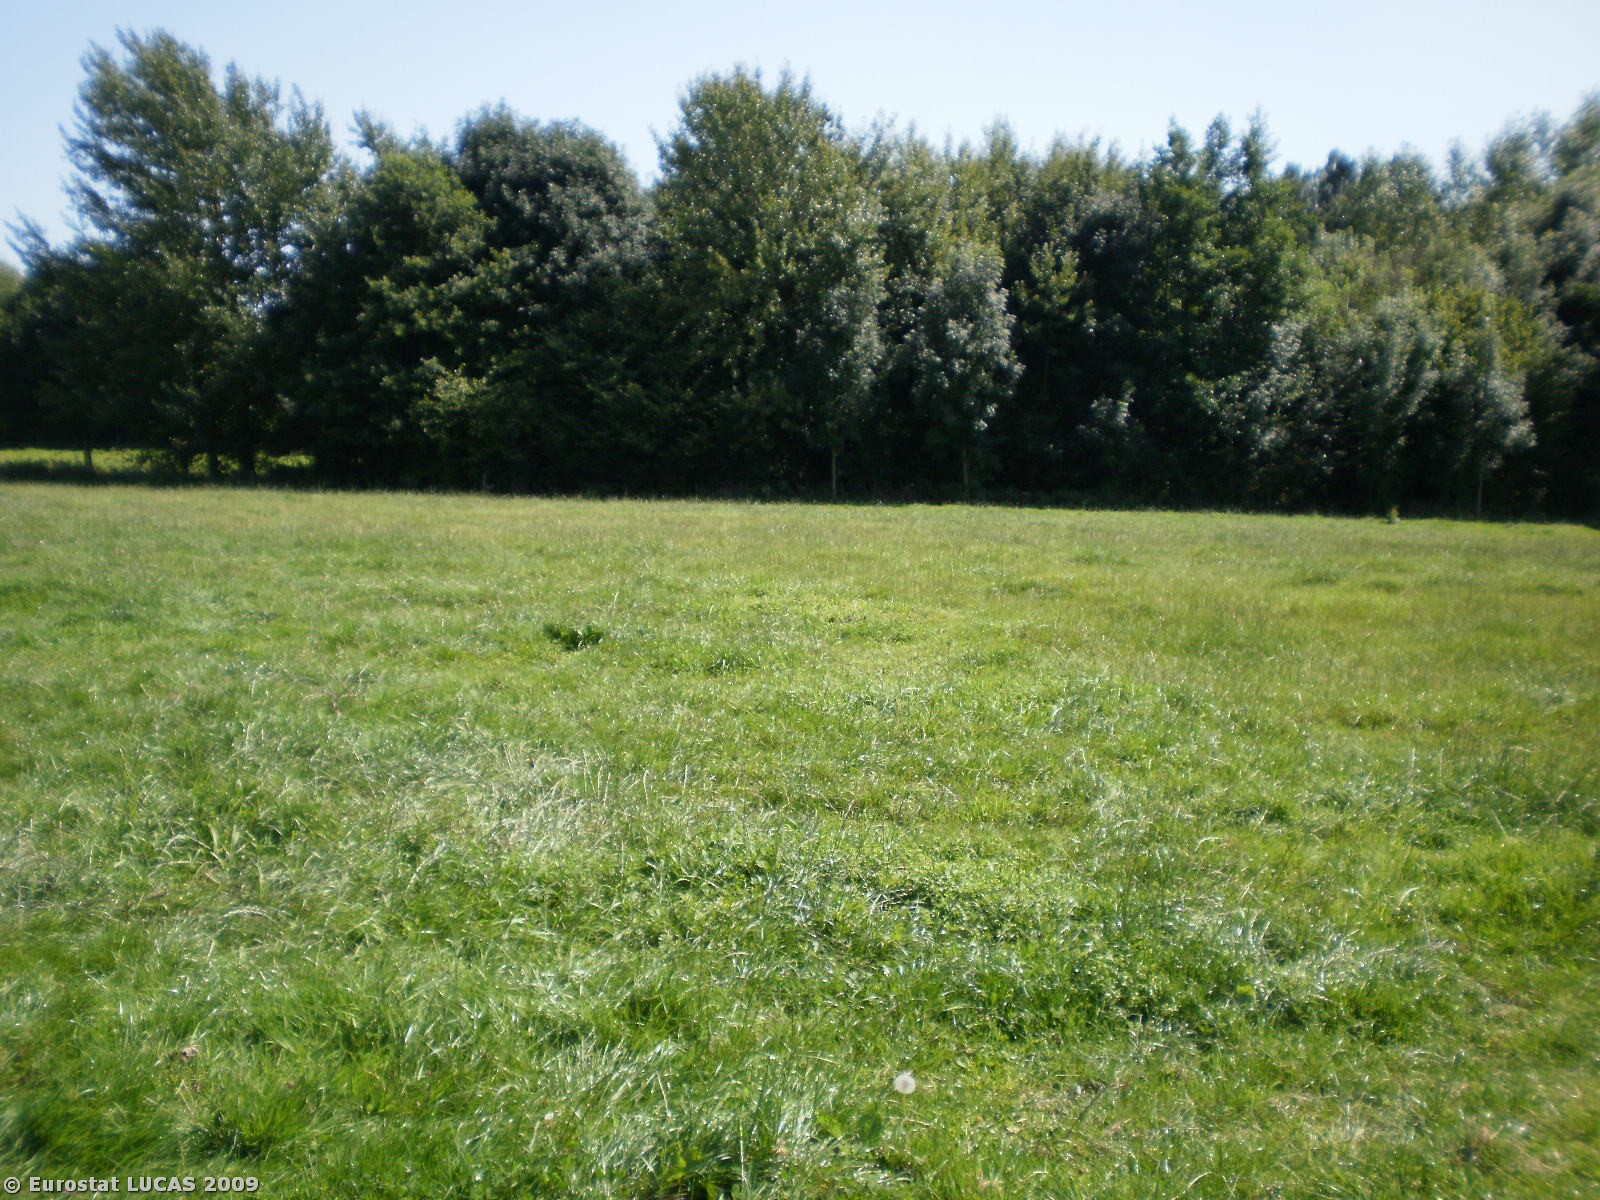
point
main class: Grassland
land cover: Grassland without tree/shrub cover
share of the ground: > 75 %
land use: Agriculture (excluding fallow land and kitchen gardens)
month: August
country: BE
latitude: 50.7907
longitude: 3.7942
